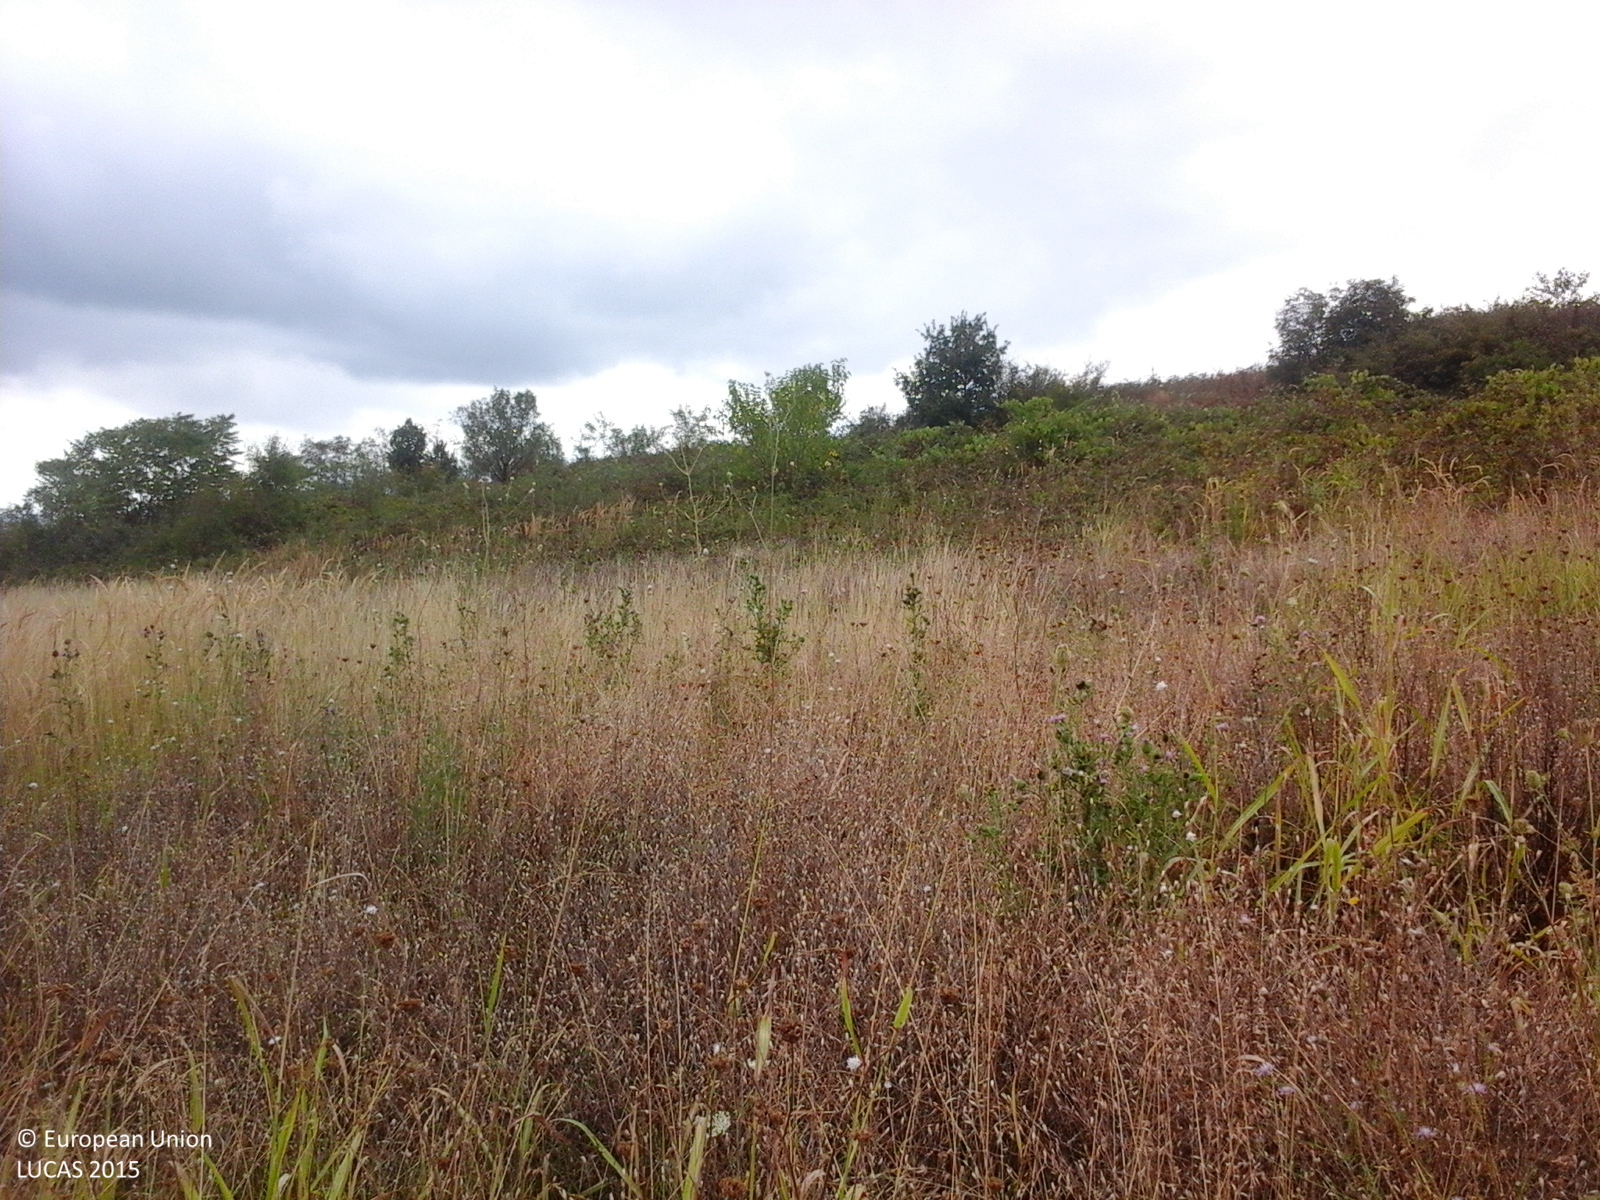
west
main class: Grassland
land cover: Spontaneously vegetated surfaces
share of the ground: > 75 %
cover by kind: herbaceous plants 100 %
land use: Fallow land
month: August
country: RO
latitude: 44.7727
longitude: 21.5907
